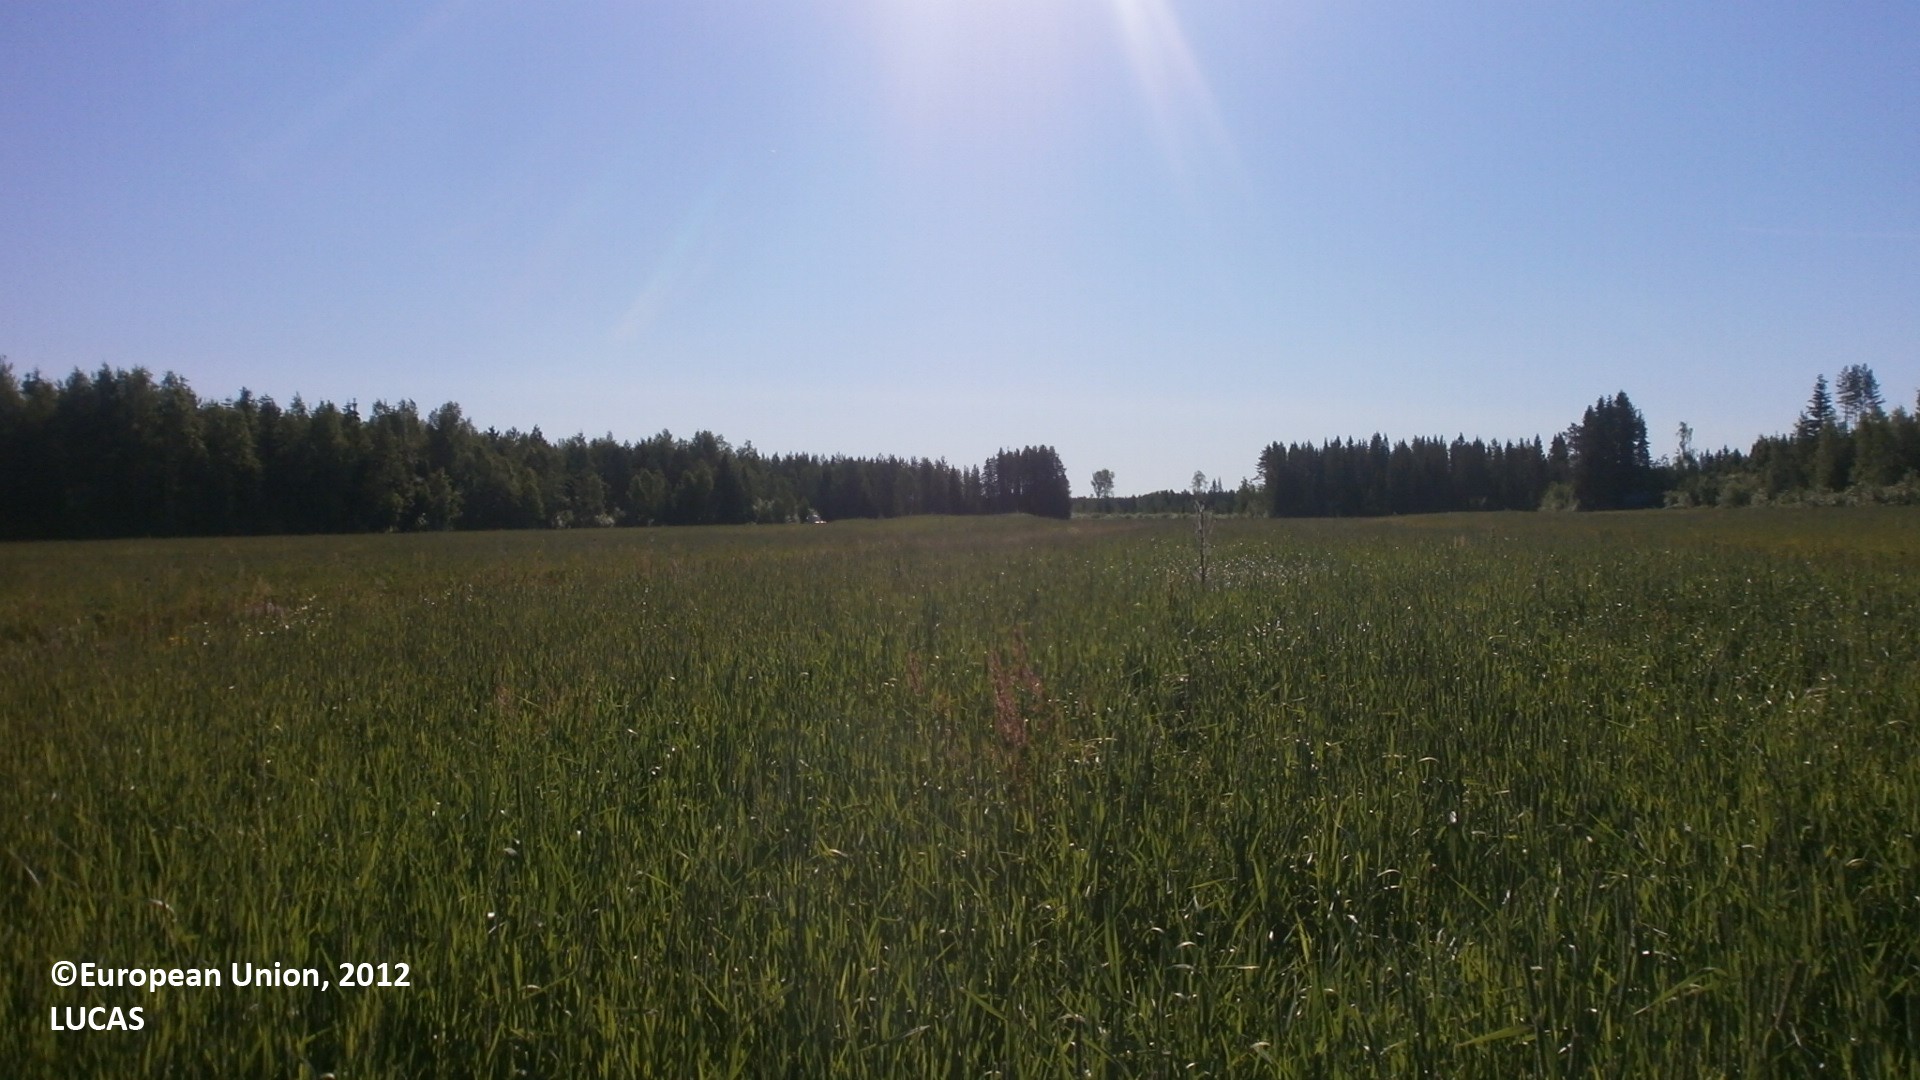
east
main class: Cropland
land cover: Temporary grasslands
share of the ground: > 75 %
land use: Agriculture (excluding fallow land and kitchen gardens)
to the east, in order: Temporary grasslands; Ditches and canals; Temporary grasslands; Ditches and canals; Shruby margins; Temporary grasslands; Ditches and canals; Shruby margins; Temporary grasslands; Shruby margins; Ditches and canals; Spruce dominated mixed woodland
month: July
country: FI
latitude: 64.1952
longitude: 25.0102
